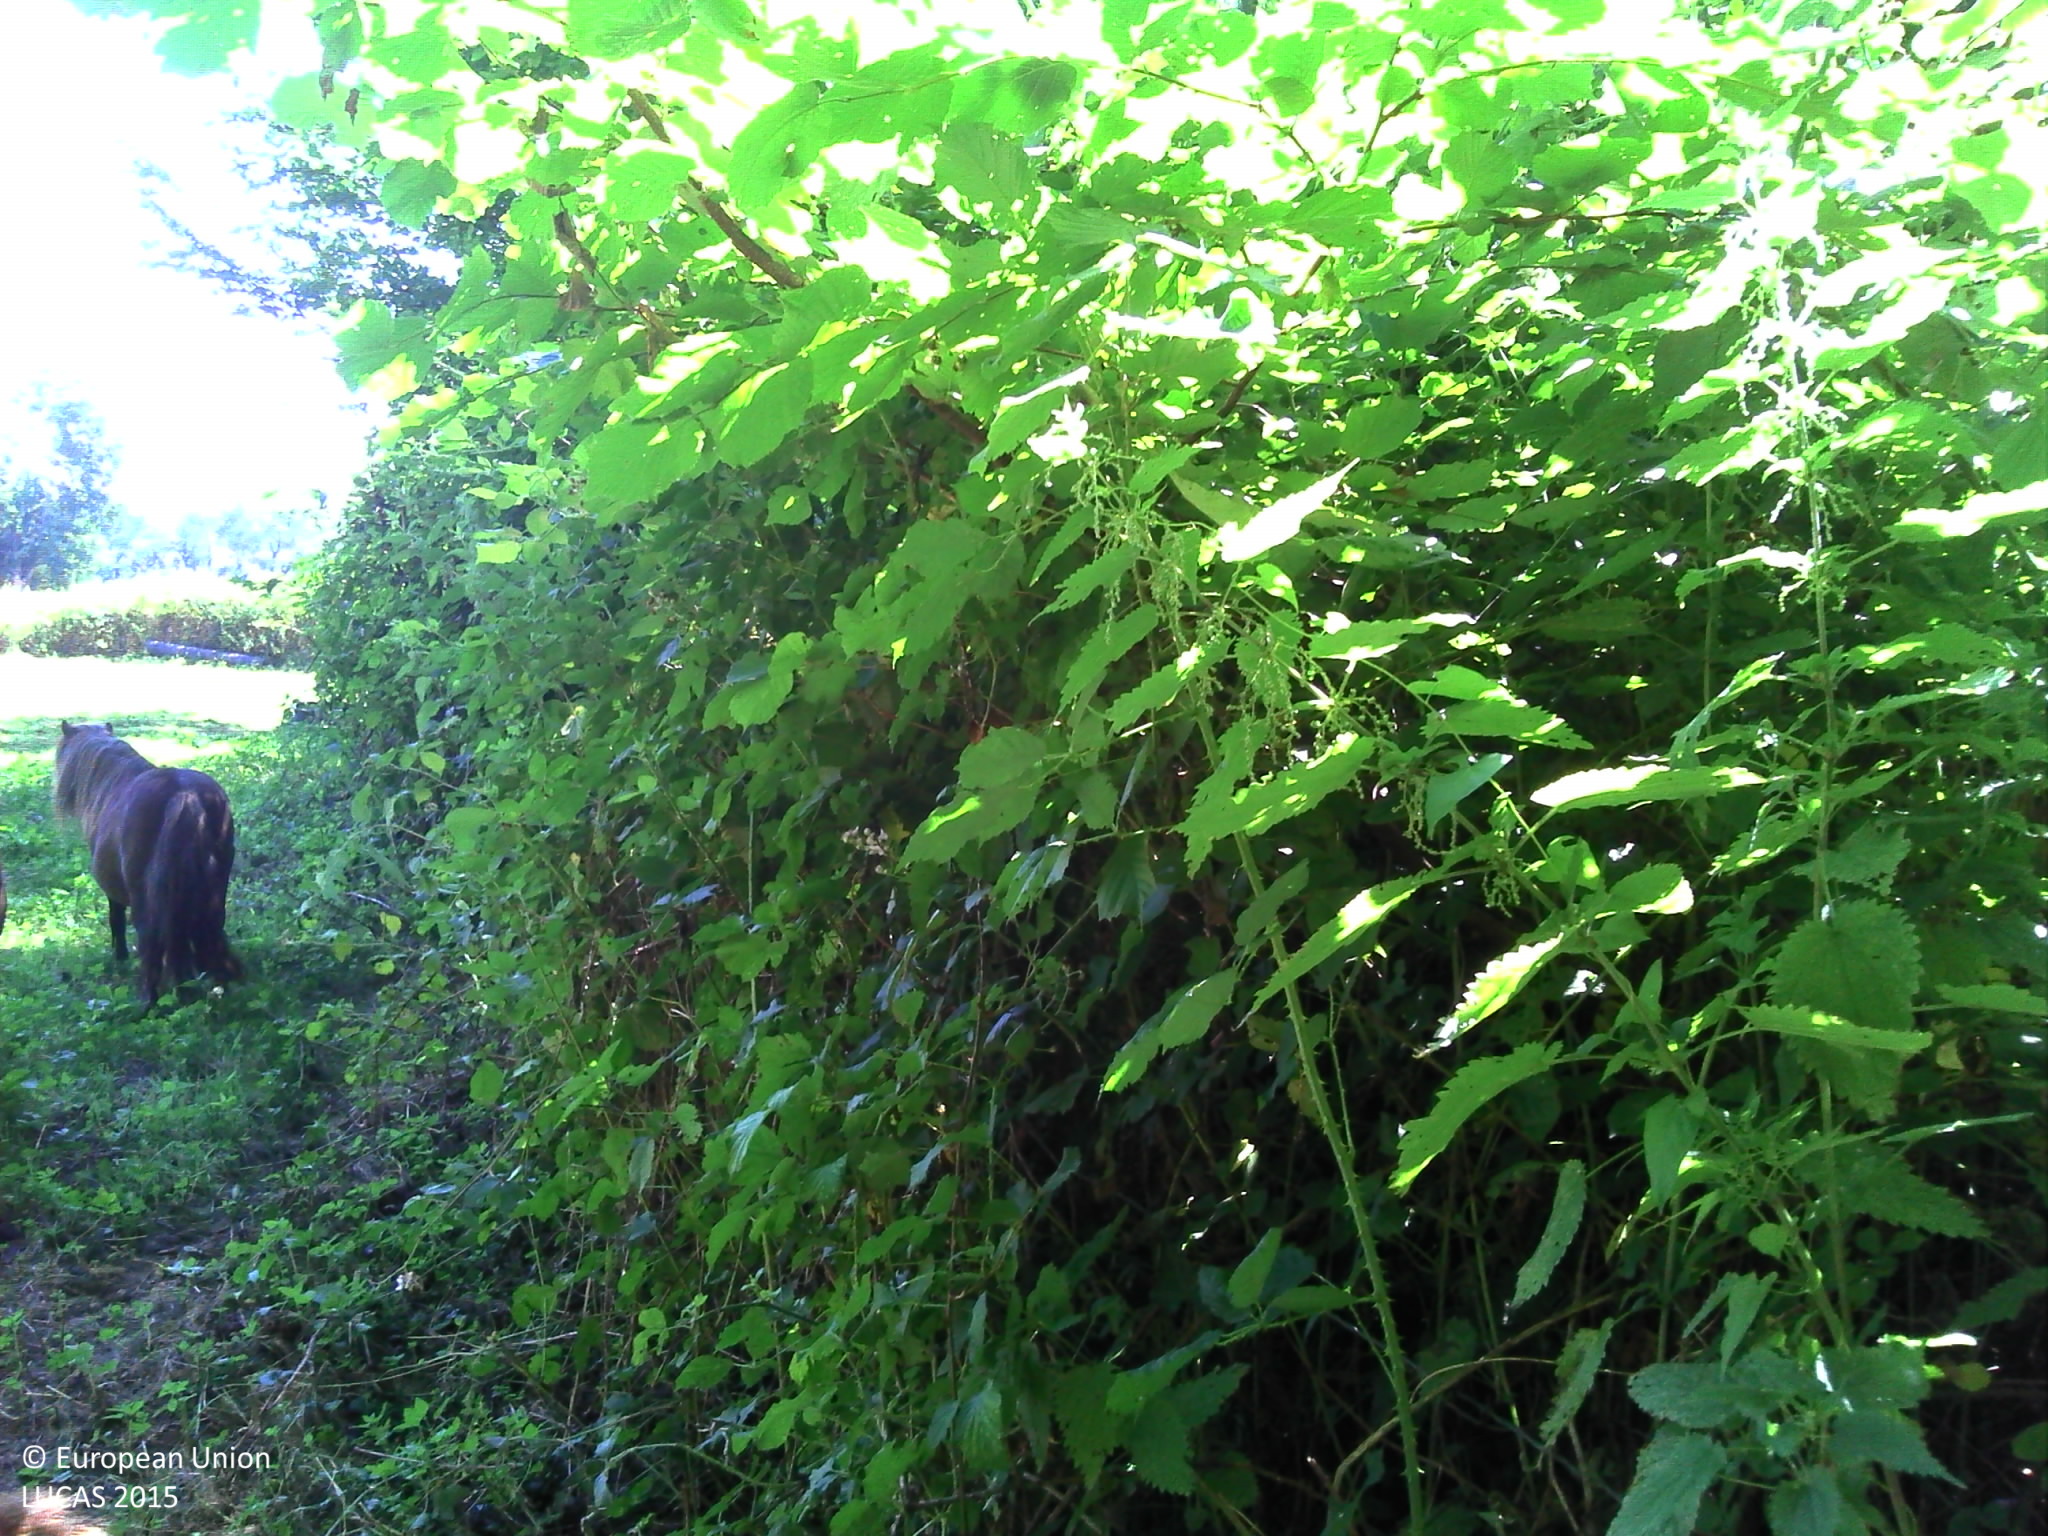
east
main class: Woodland
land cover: Broadleaved woodland
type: thermophilous deciduous forest
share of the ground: > 75 %
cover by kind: broadleaved forest trees 80 %, shrubs 20 %
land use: Forestry
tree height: > 5 m
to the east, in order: Broadleaved woodland; Fences; Ditches and canals; Grass margins; Paved roads, cycling and walking lanes; Grass margins; Ditches and canals; Lines of trees; Fences; Grassland without tree/shrub cover; Fences; Ditches and canals; Grass margins; Paved roads, cycling and walking lanes; Grass margins; Ditches and canals; Fences; Grassland without tree/shrub cover; Managed hedges; Fences; Grassland without tree/shrub cover; Managed hedges; Fences; Grassland without tree/shrub cover
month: June
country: FR
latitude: 46.6858
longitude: 5.4129
